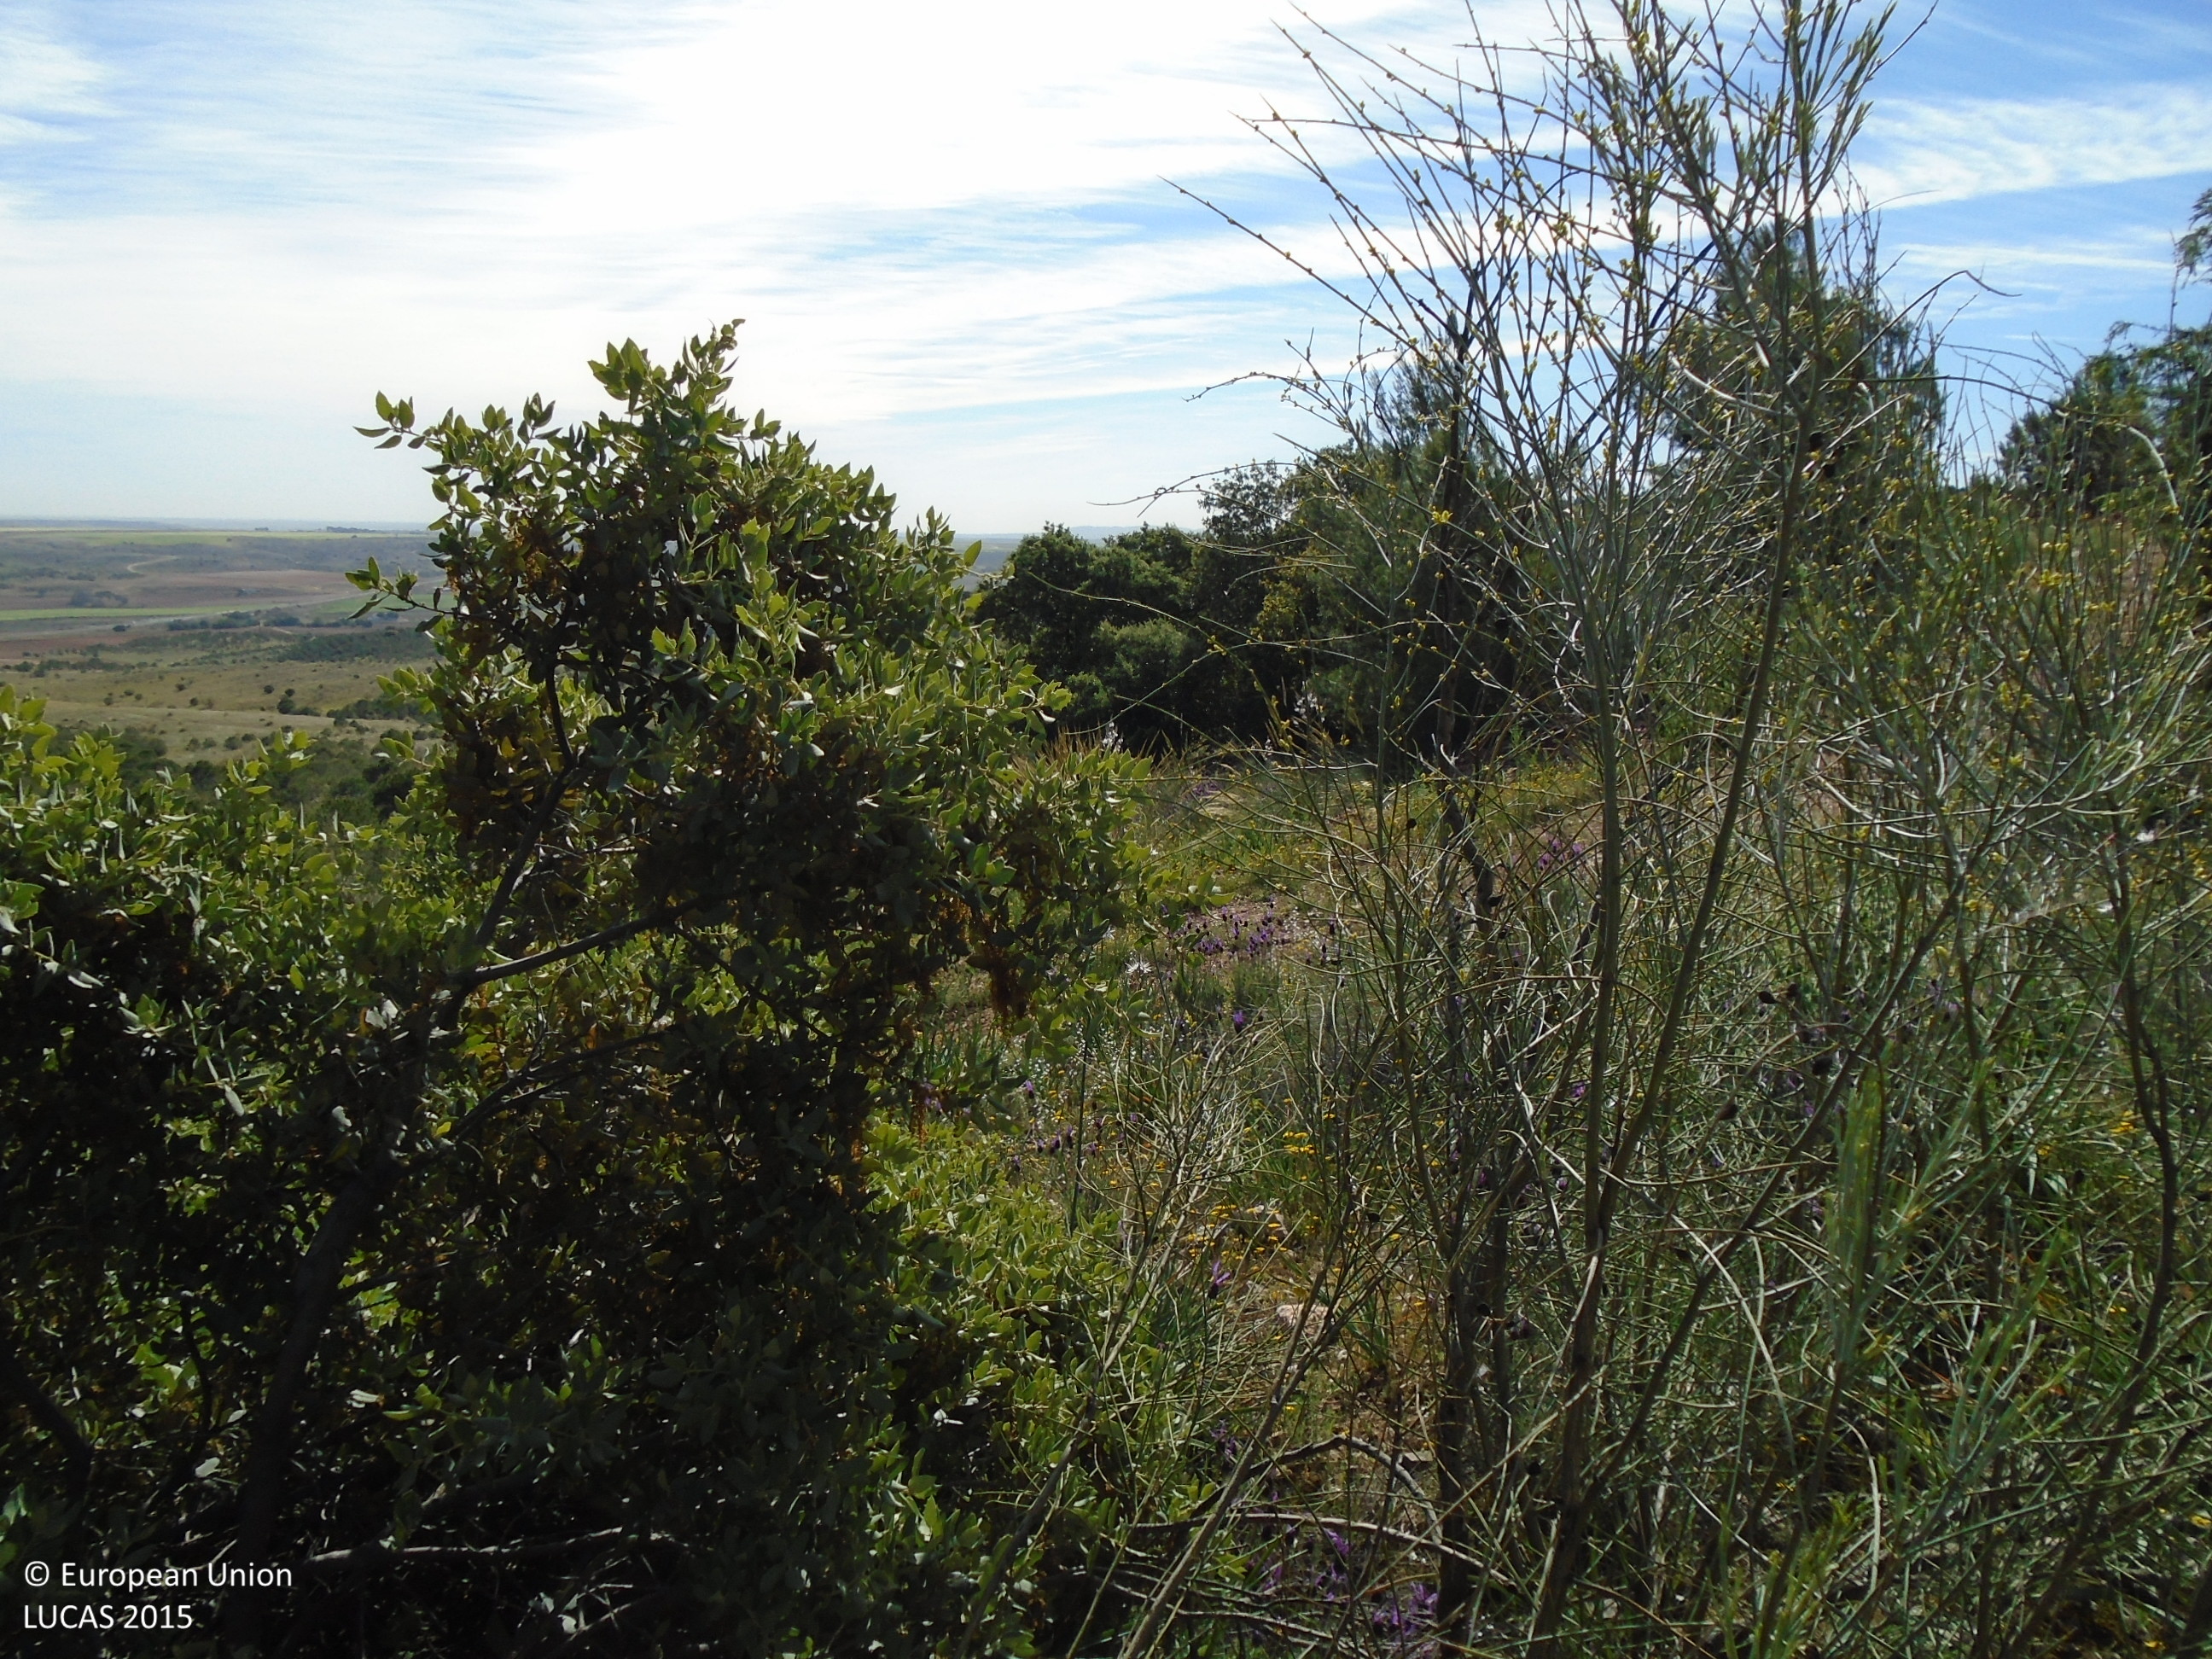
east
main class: Grassland
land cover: Grassland with sparse tree/shrub cover
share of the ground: > 75 %
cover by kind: herbaceous plants 85 %, coniferous forest trees 5 %, shrubs 5 %, consolidated bare surface 5 %
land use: Semi-natural and natural areas not in use
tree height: > 5 m
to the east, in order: Grassland with sparse tree/shrub cover; Tracks; Grassland with sparse tree/shrub cover; Pine dominated coniferous woodland; Tracks; Pine dominated coniferous woodland; Grassland with sparse tree/shrub cover; Pine dominated coniferous woodland
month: May
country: ES
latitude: 39.6741
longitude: -3.6552
